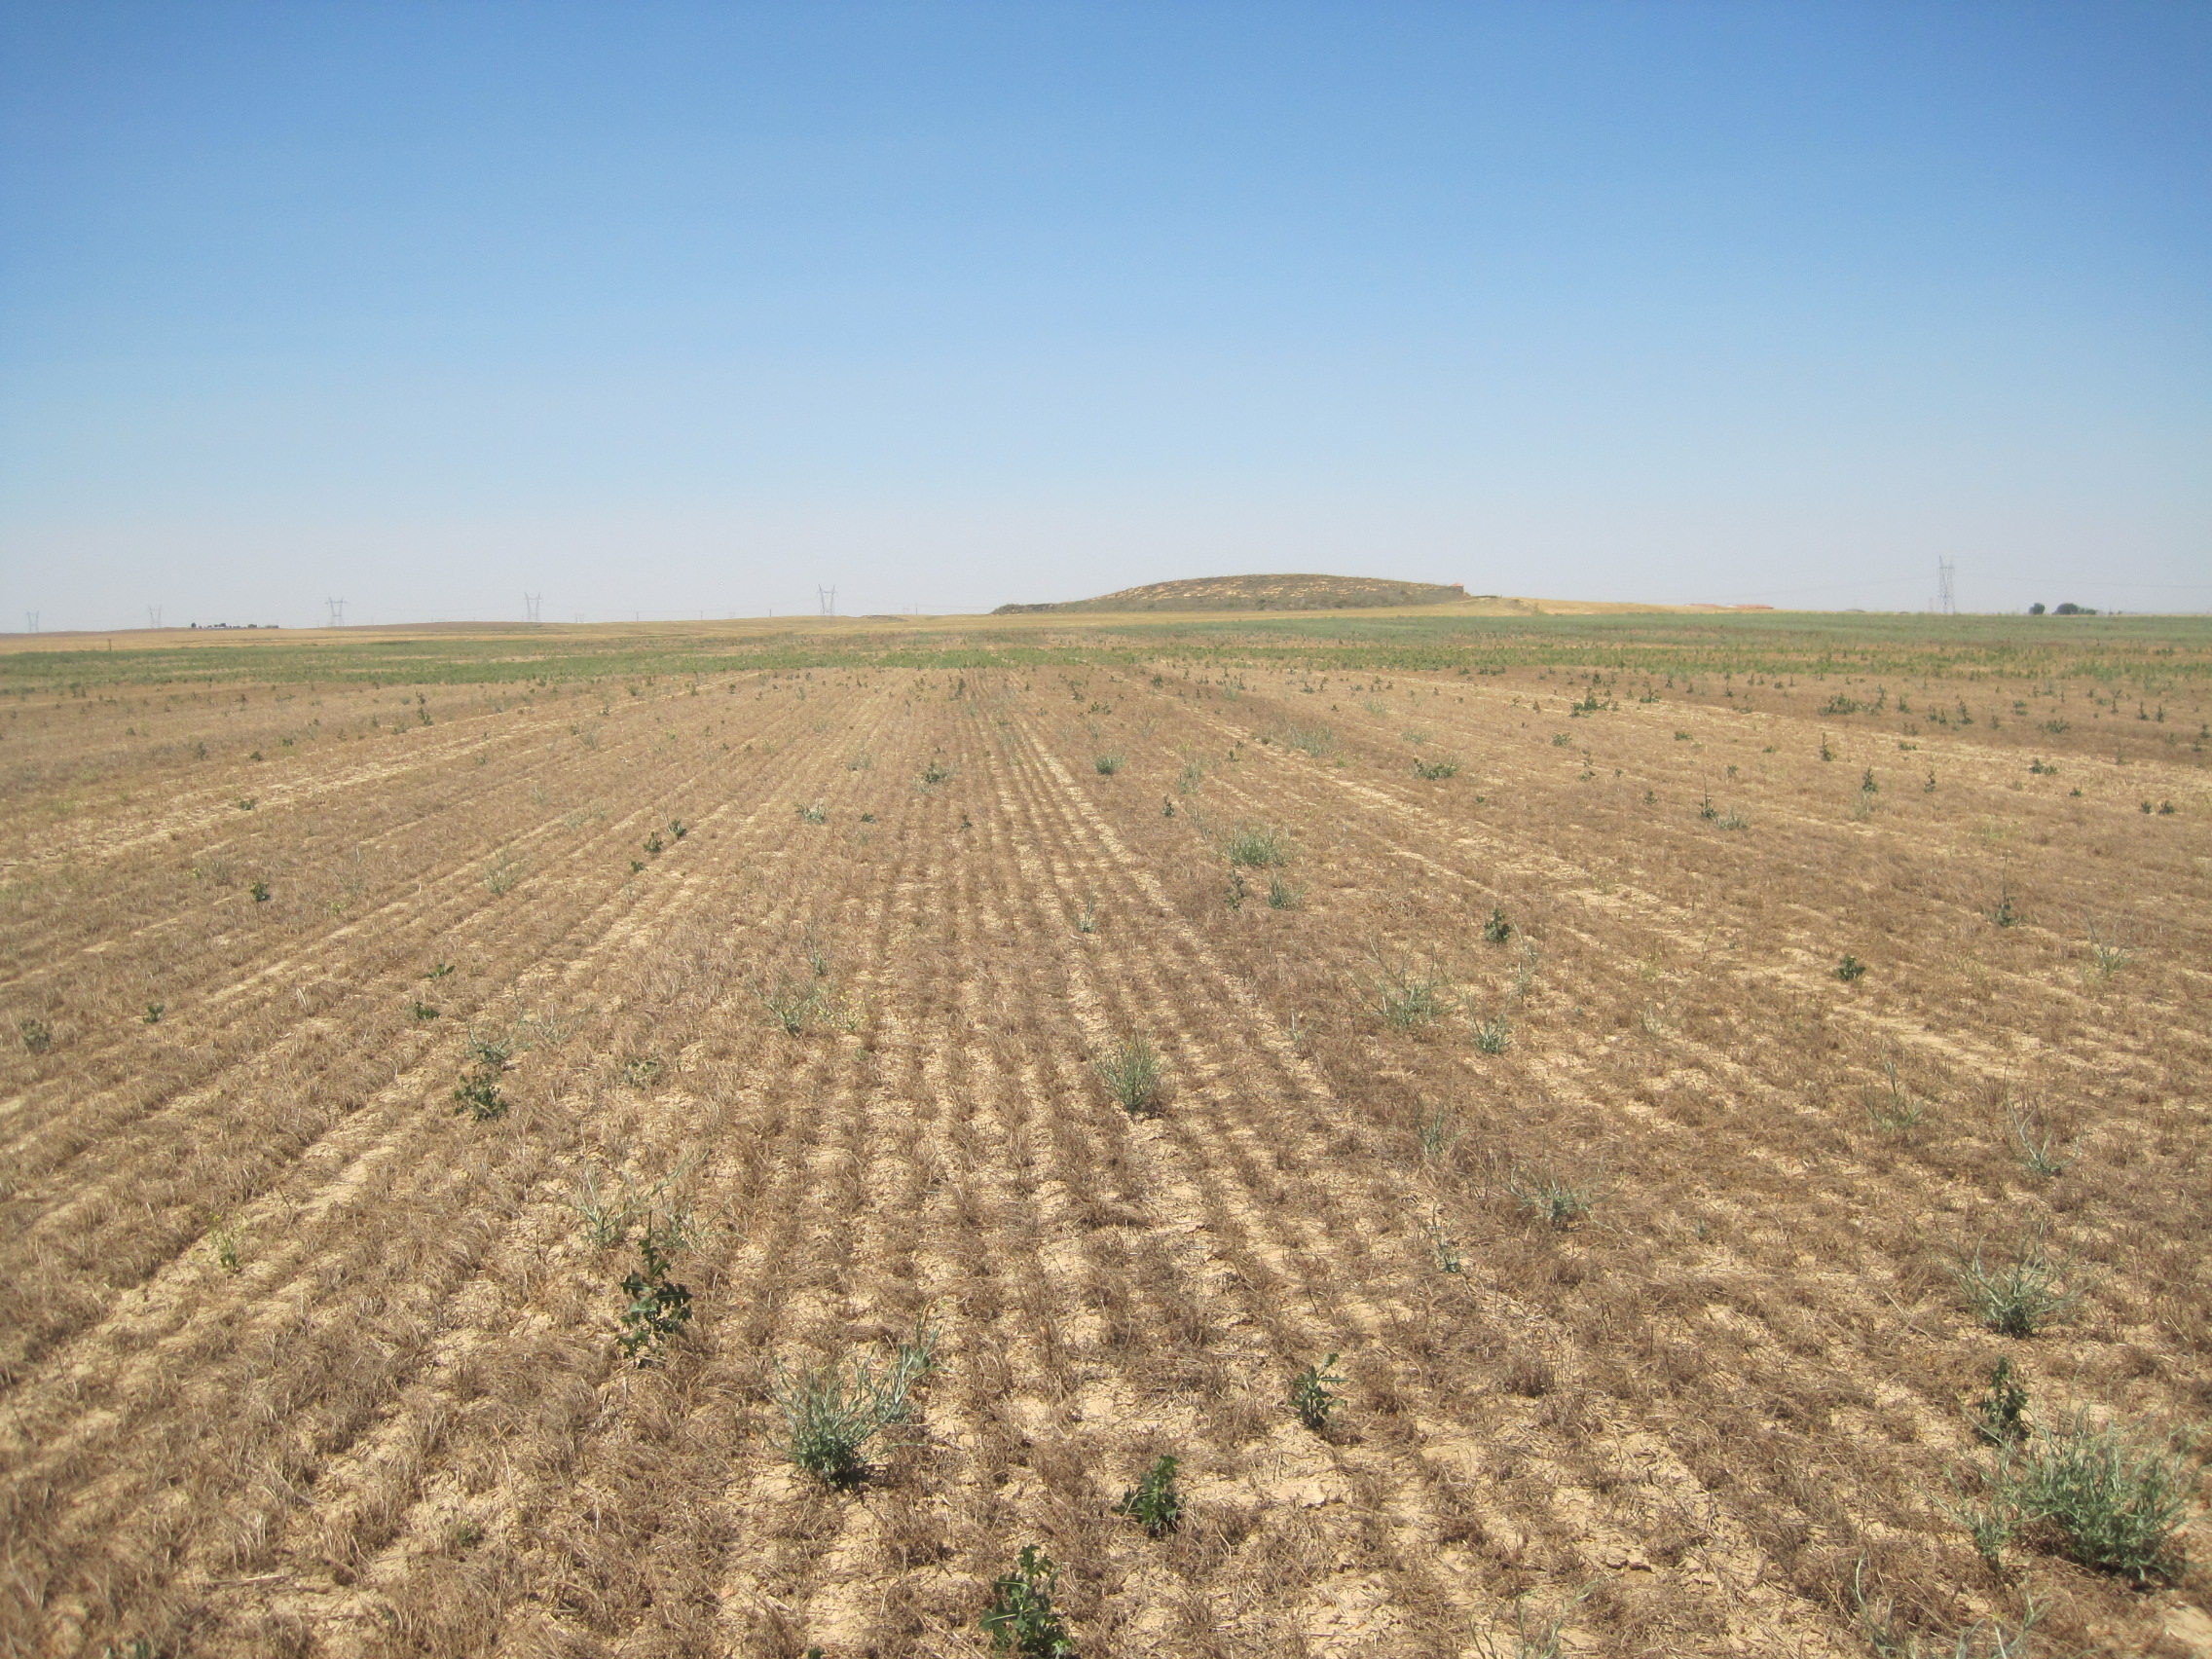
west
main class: Cropland
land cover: Dry pulses
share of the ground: < 10 %
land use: Agriculture (excluding fallow land and kitchen gardens)
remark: Harvested field
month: July
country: ES
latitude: 41.9762
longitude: -4.7118
